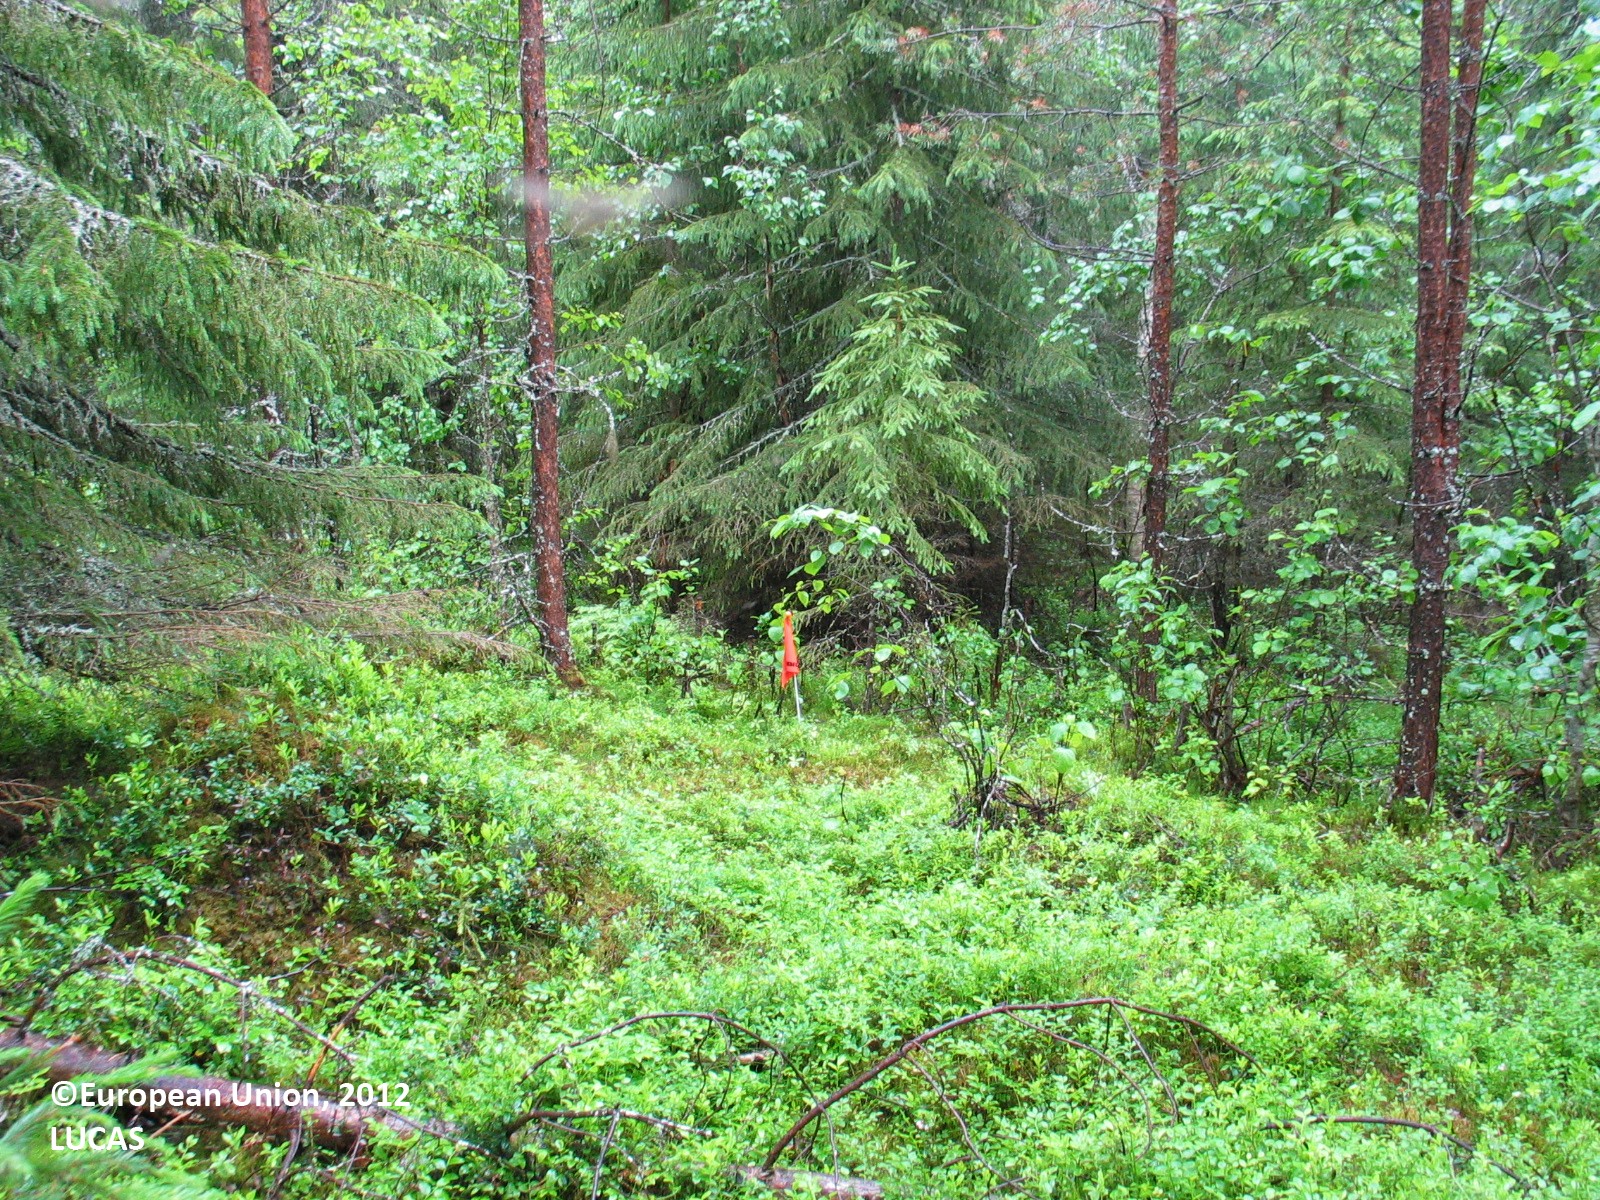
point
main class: Woodland
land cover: Pine dominated coniferous woodland
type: boreal forest
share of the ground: 25 - 50 %
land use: Forestry
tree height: > 5 m
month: July
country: FI
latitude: 66.0384
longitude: 24.8639
